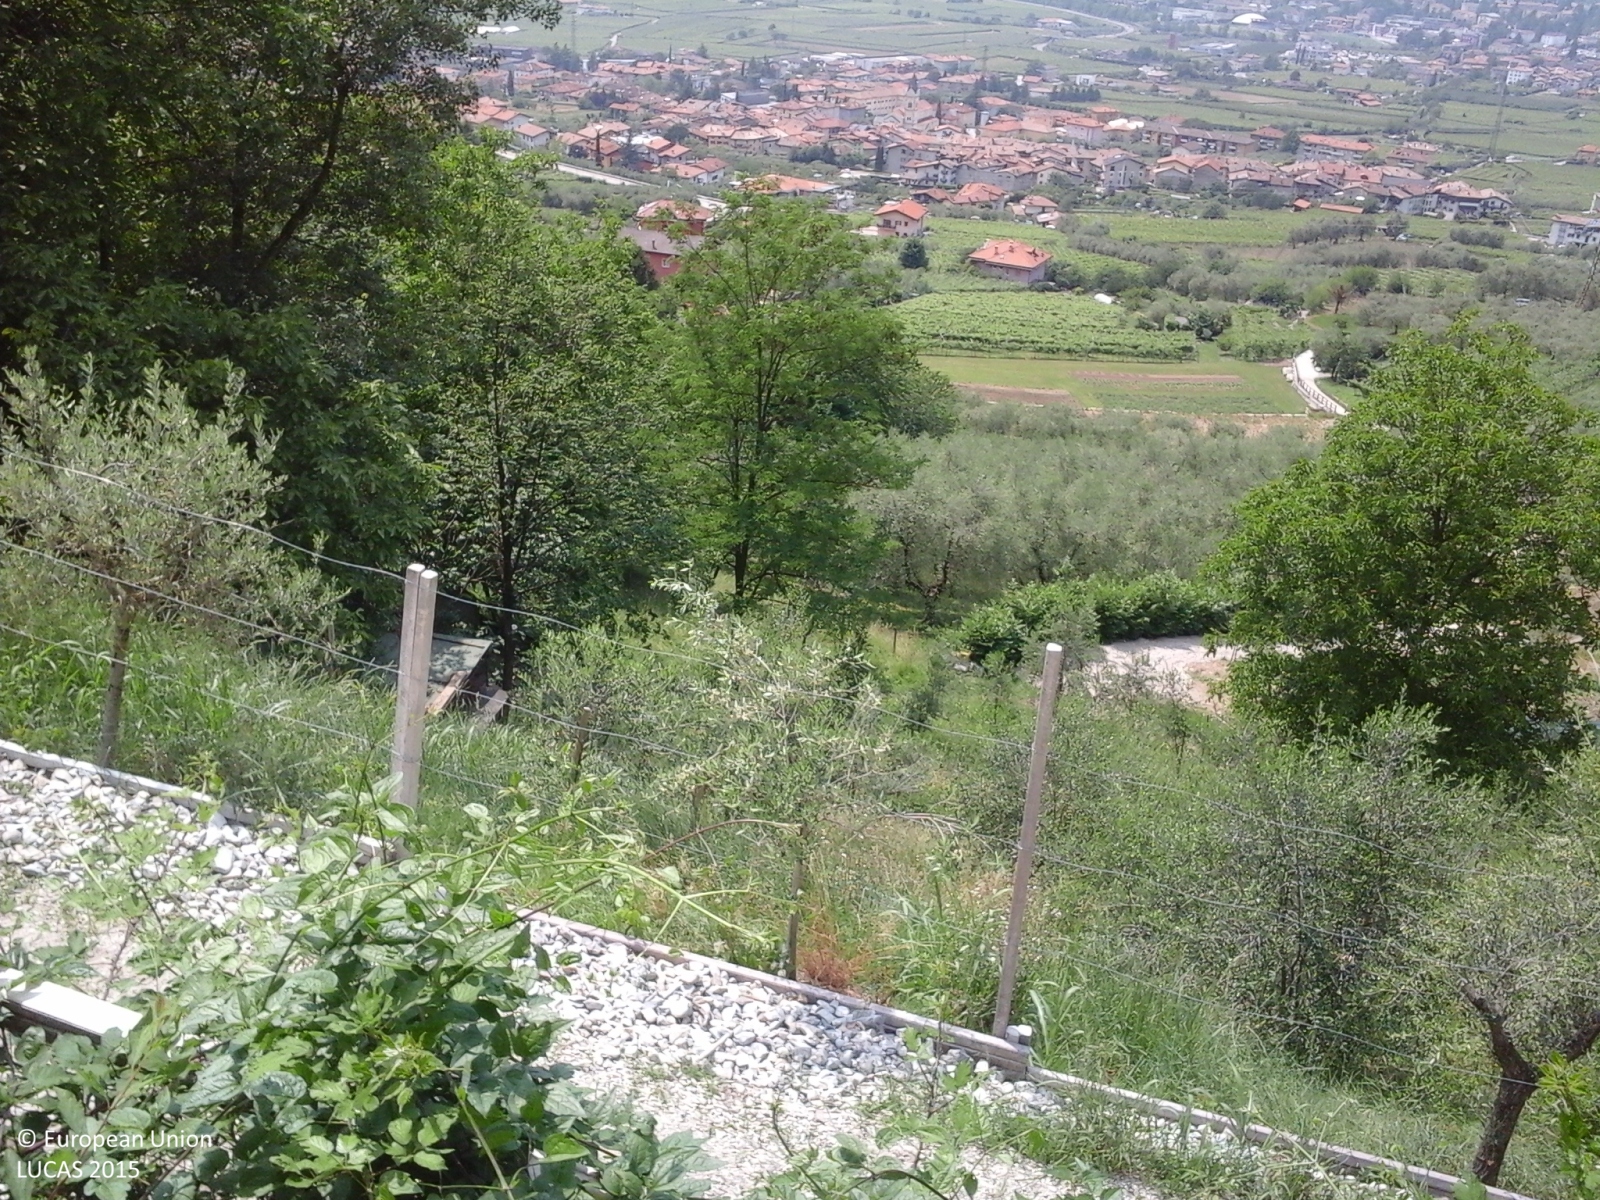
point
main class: Cropland
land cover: Olive groves
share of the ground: 50 - 75 %
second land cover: Grassland without tree/shrub cover
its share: > 75 %
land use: Agriculture (excluding fallow land and kitchen gardens)
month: June
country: IT
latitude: 45.9149
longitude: 10.9140
